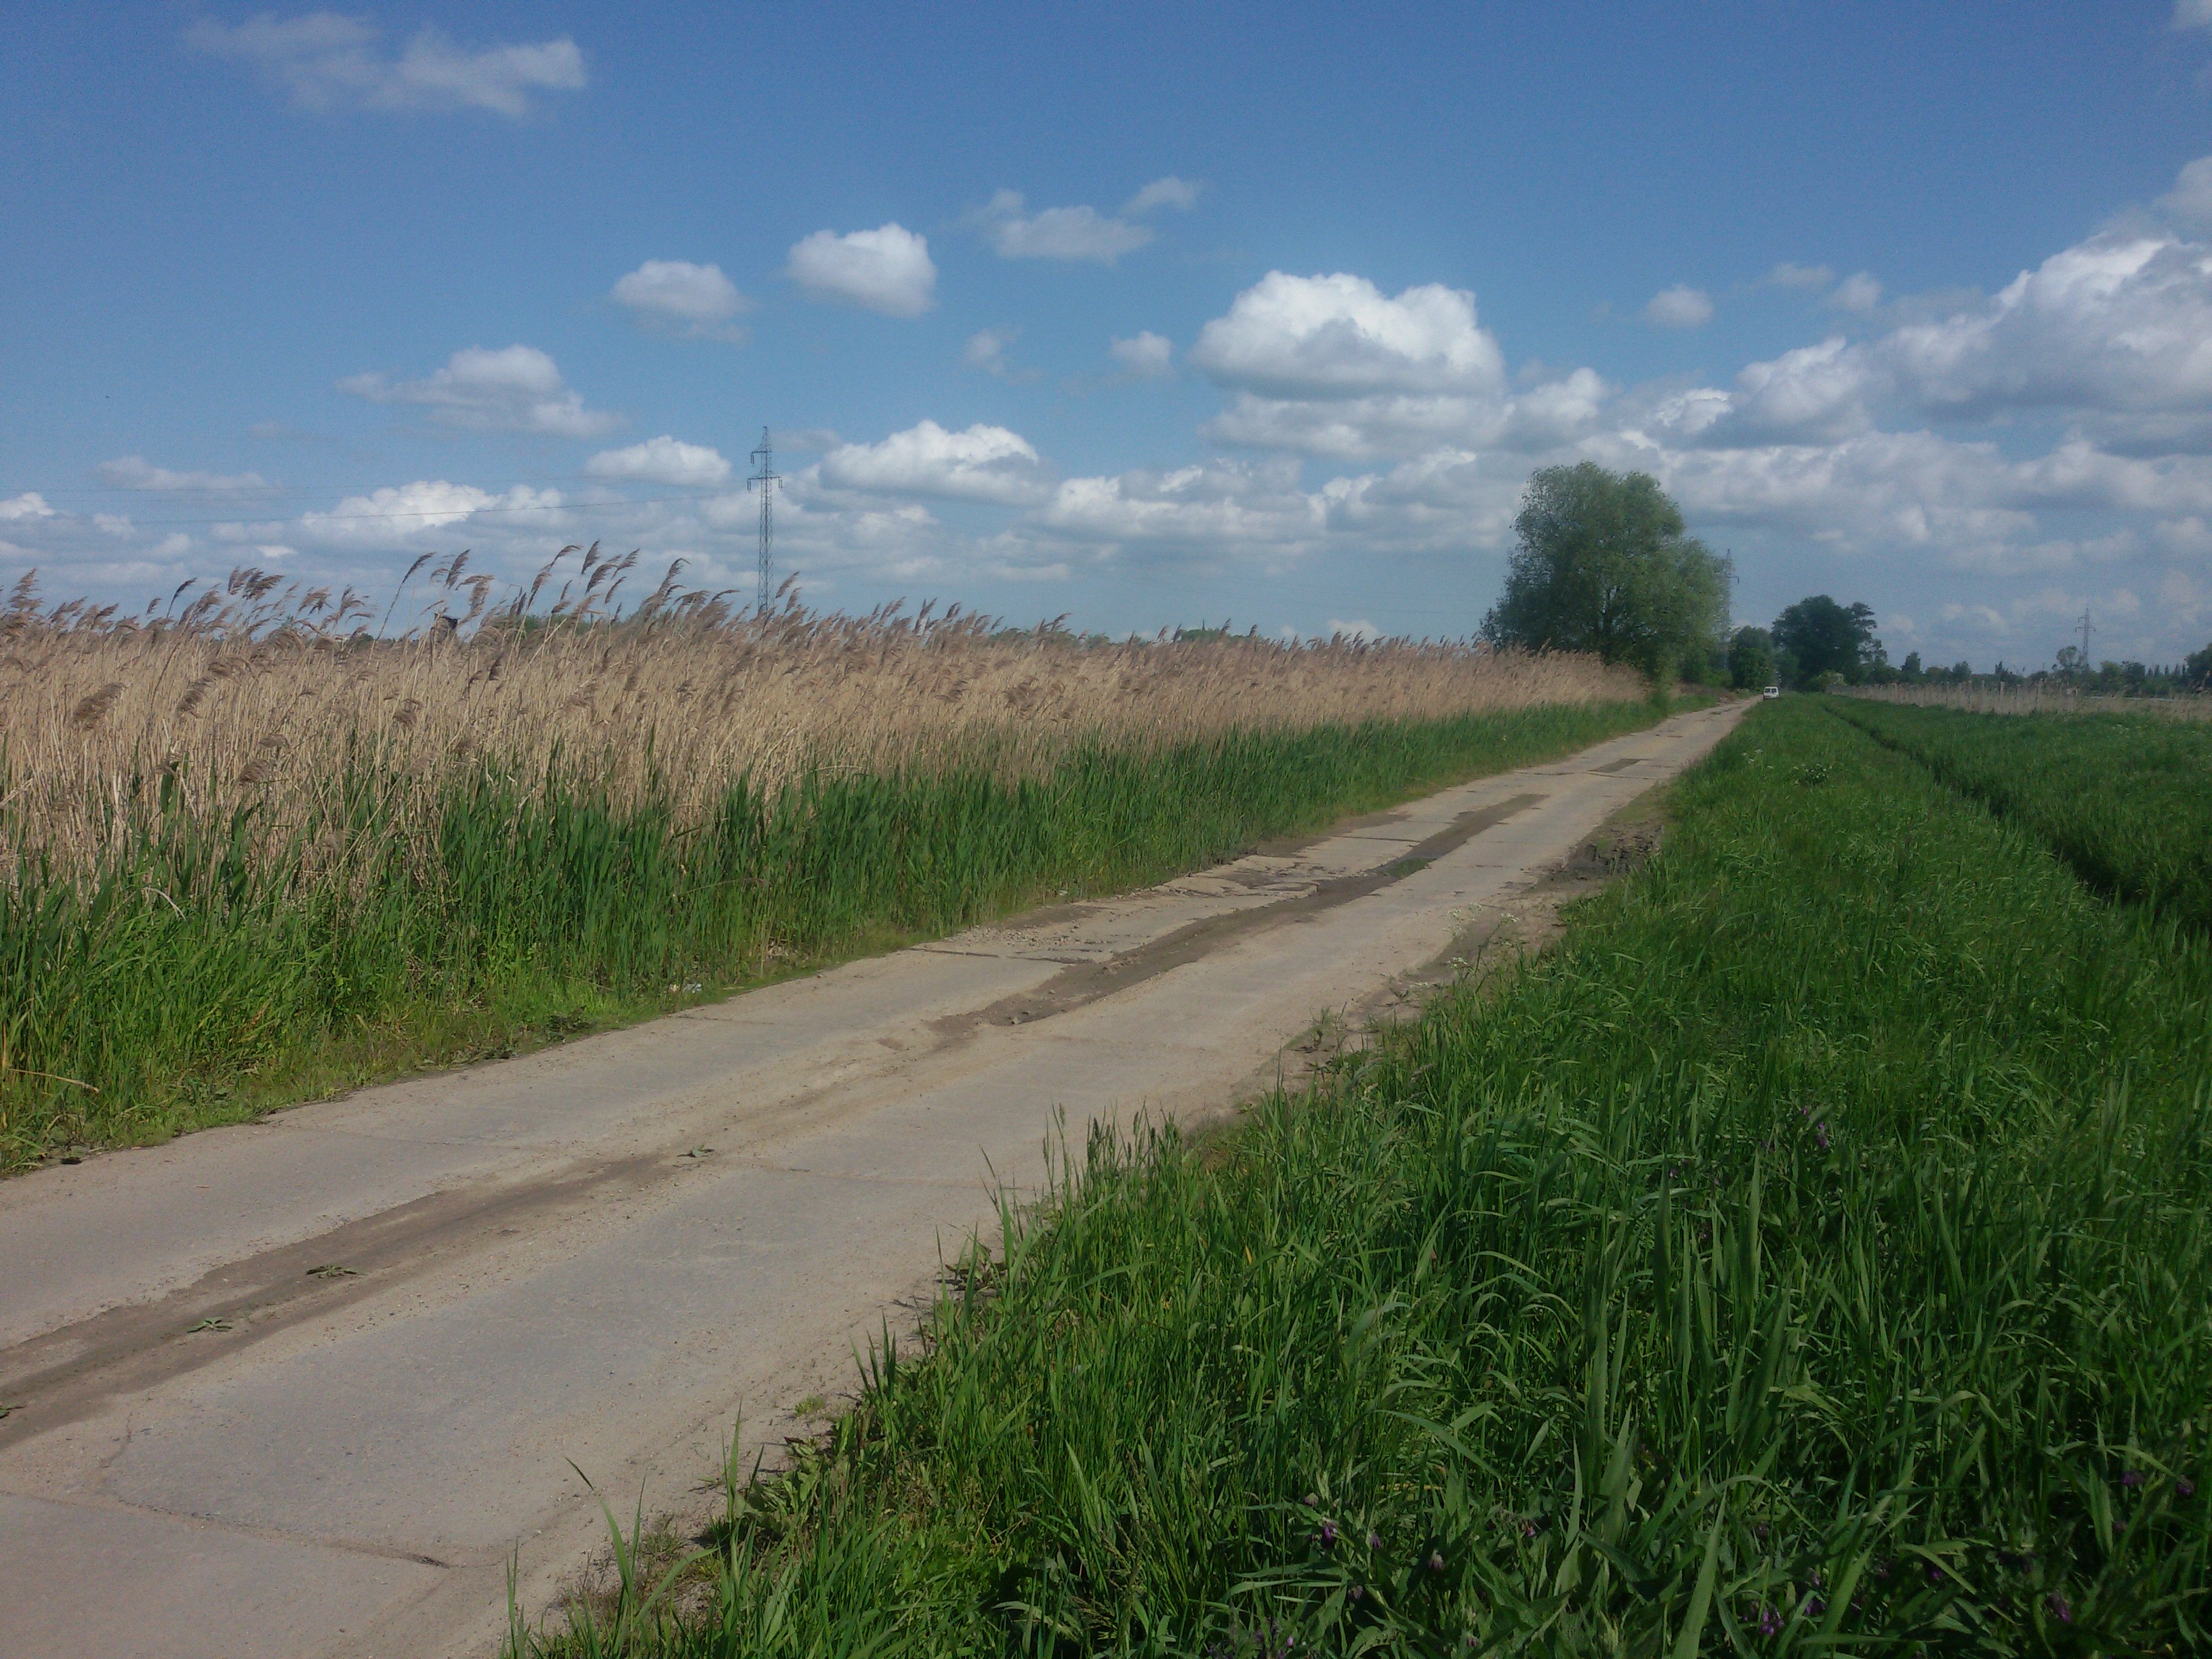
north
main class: Grassland
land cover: Grassland without tree/shrub cover
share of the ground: > 75 %
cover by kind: herbaceous plants 100 %
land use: Semi-natural and natural areas not in use
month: May
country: PL
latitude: 53.3882
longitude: 14.5571
